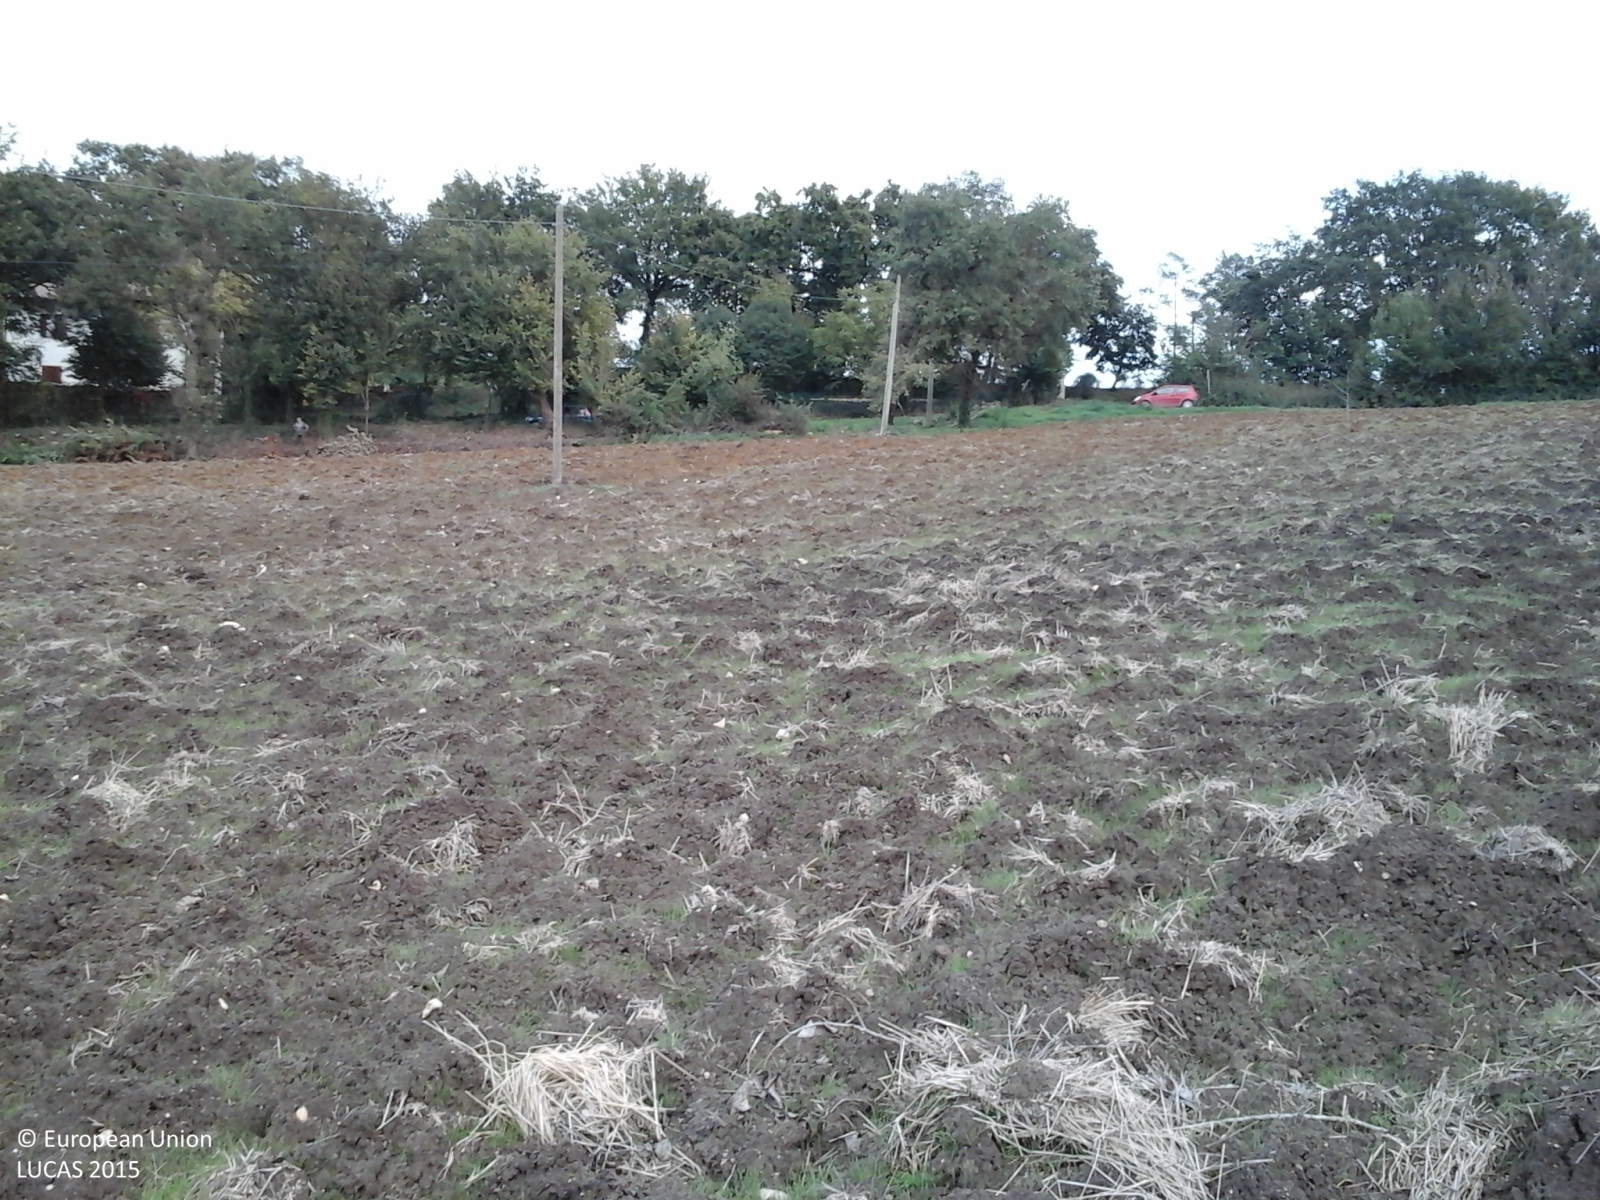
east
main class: Cropland
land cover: Common wheat
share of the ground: < 10 %
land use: Agriculture (excluding fallow land and kitchen gardens)
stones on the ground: 10 - 25 %
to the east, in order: Common wheat; Electric lines; Common wheat; Broadleaved woodland; Fences; Tracks; Fences; Broadleaved woodland; Paved roads, cycling and walking lanes; Managed hedges; Grassland with sparse tree/shrub cover; Electric lines; Fences; Tracks; Other bare soil
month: October
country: IT
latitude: 42.7124
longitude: 12.5439
